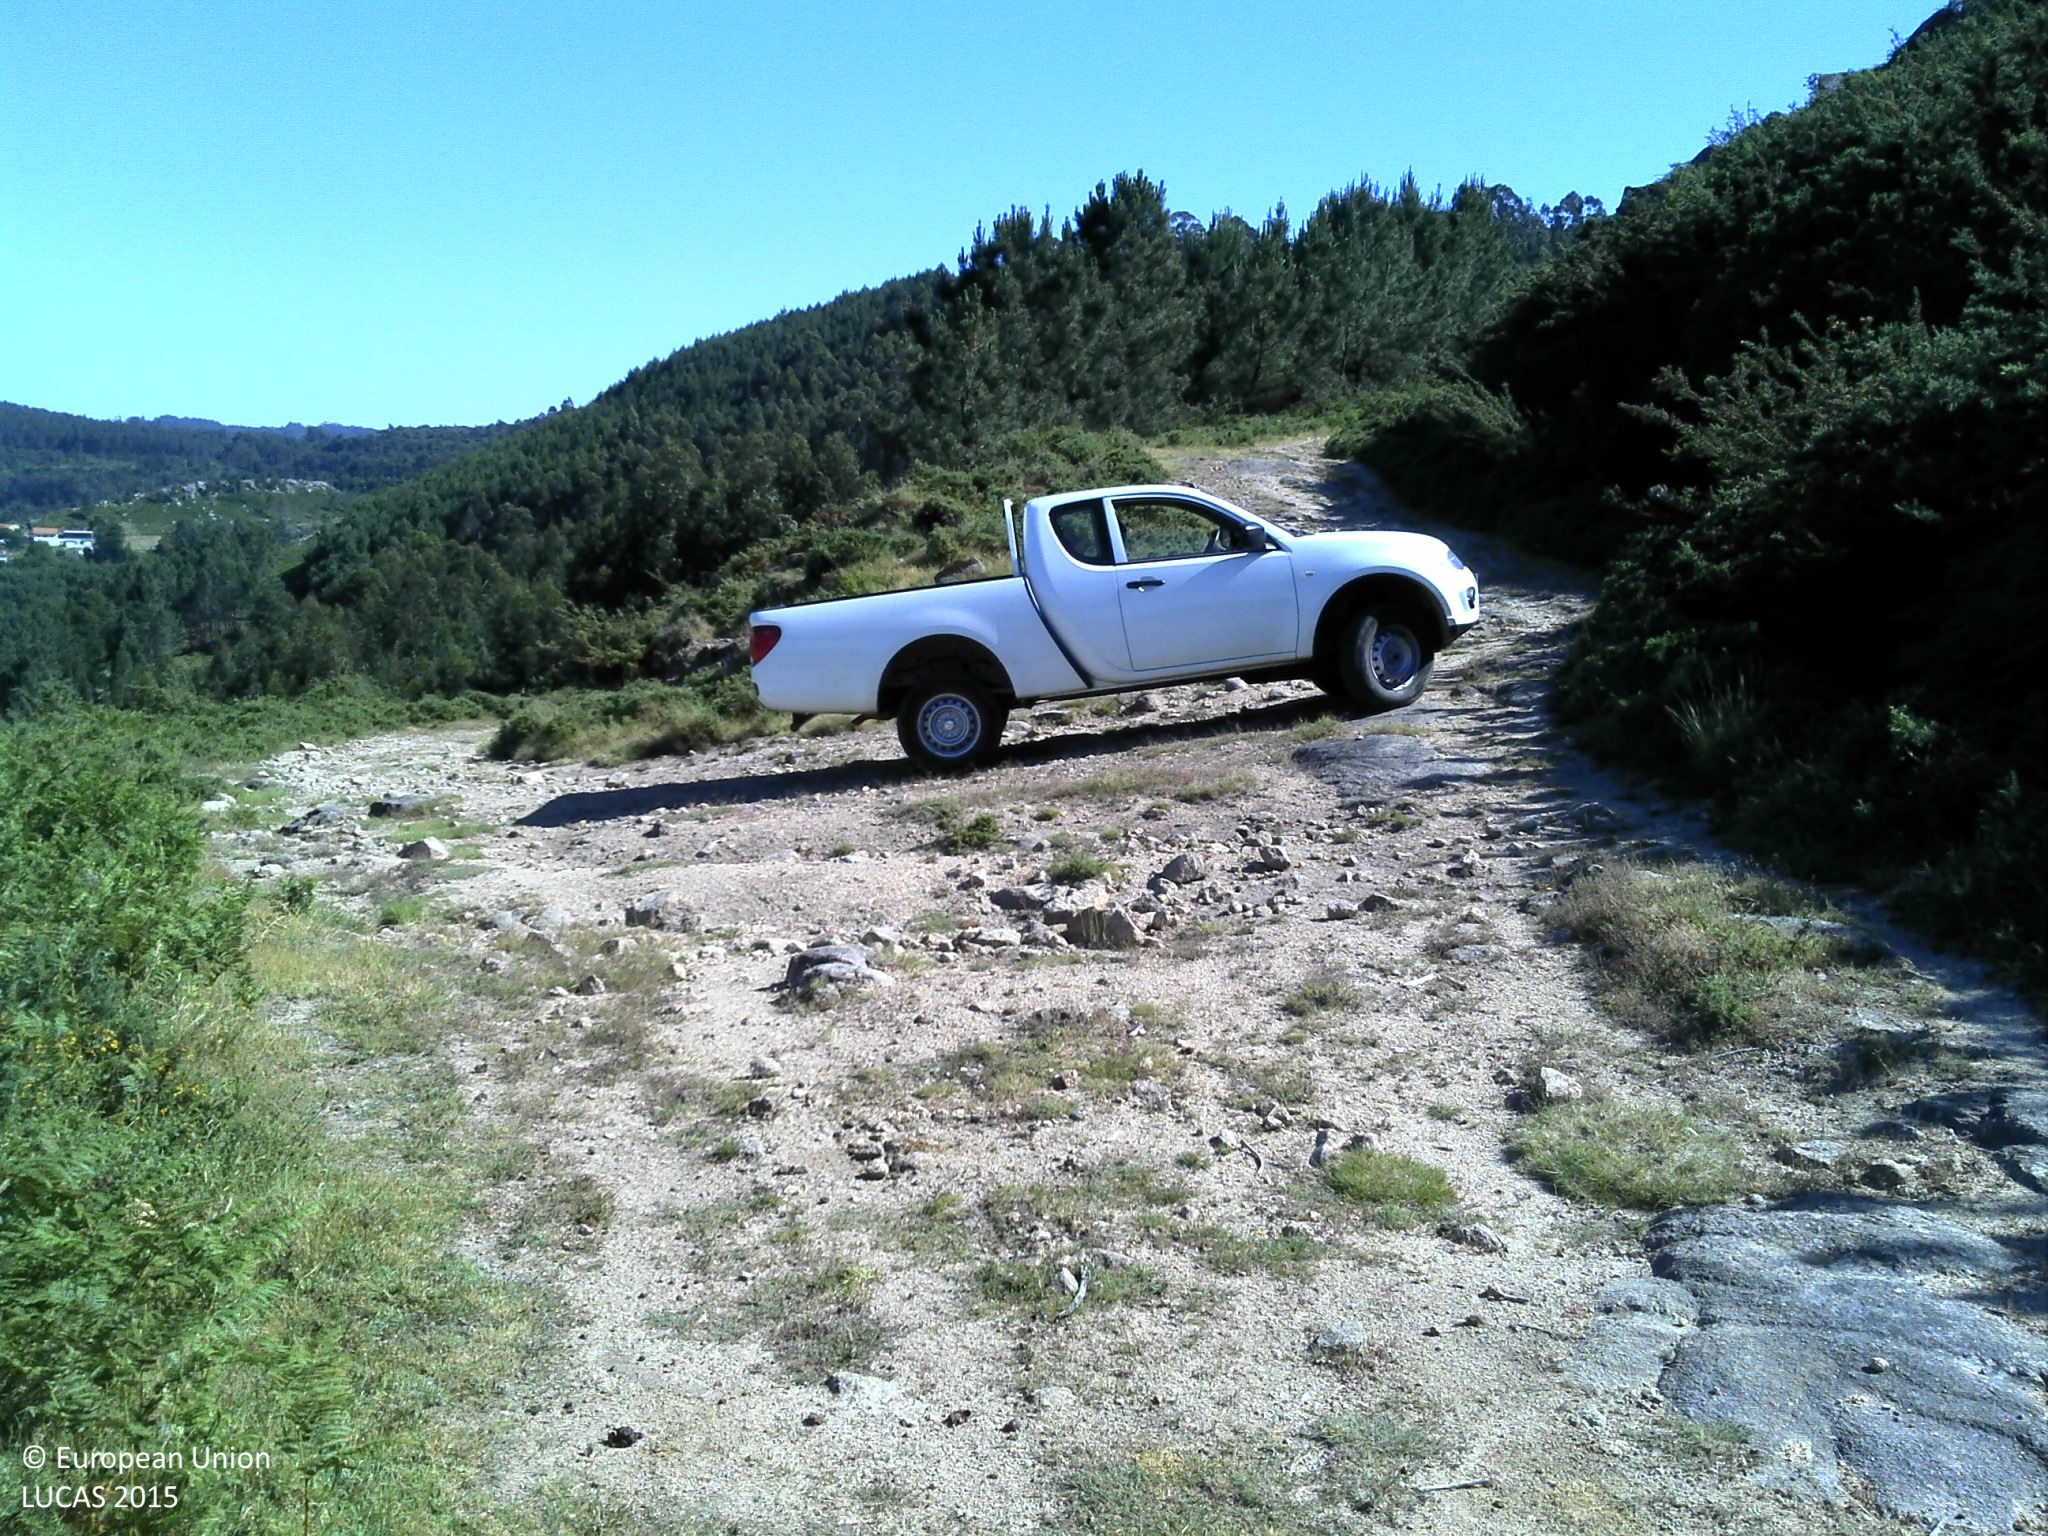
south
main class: Shrubland
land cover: Shrubland without tree cover
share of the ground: > 75 %
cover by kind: shrubs 80 %, herbaceous plants 15 %, unconsolidated bare surface 5 %
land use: Semi-natural and natural areas not in use
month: May
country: PT
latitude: 41.7281
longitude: -8.5911
